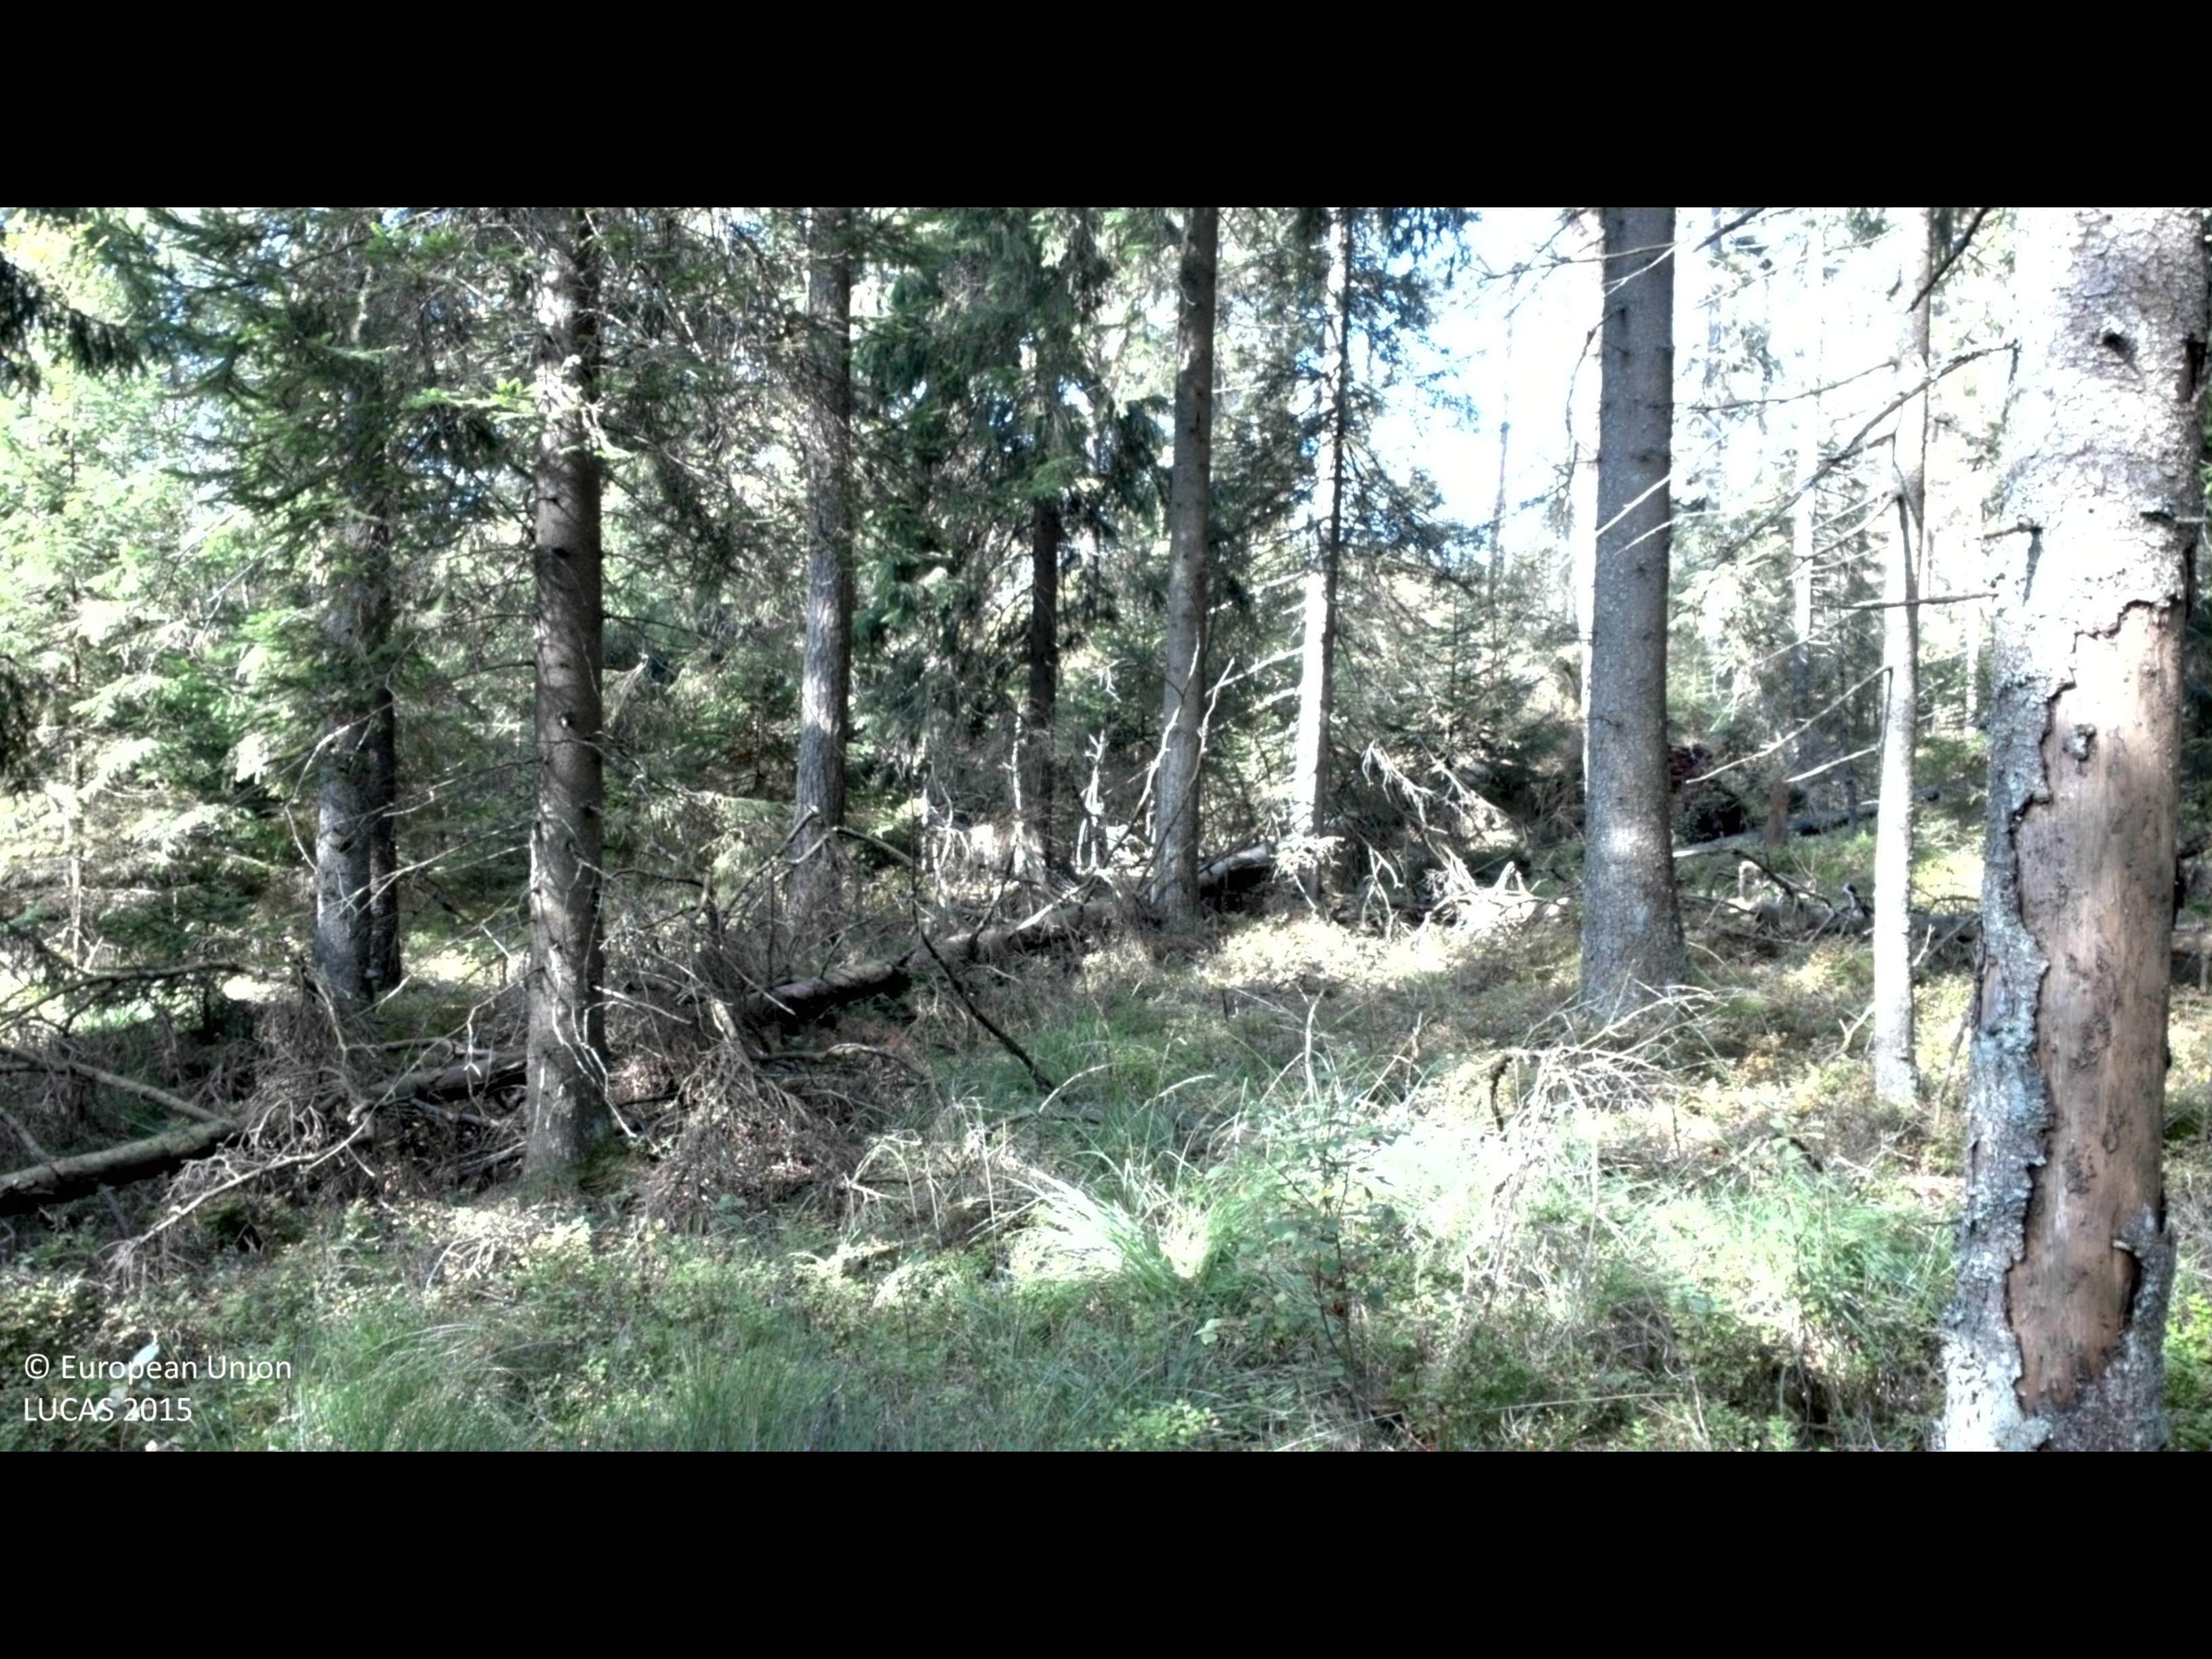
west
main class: Woodland
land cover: Spruce dominated coniferous woodland
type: boreal forest
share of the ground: 50 - 75 %
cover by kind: coniferous forest trees 65 %, shrubs 25 %, broadleaved forest trees 5 %, herbaceous plants 5 %
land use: Forestry
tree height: > 5 m
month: September
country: SE
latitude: 56.8147
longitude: 13.1582
